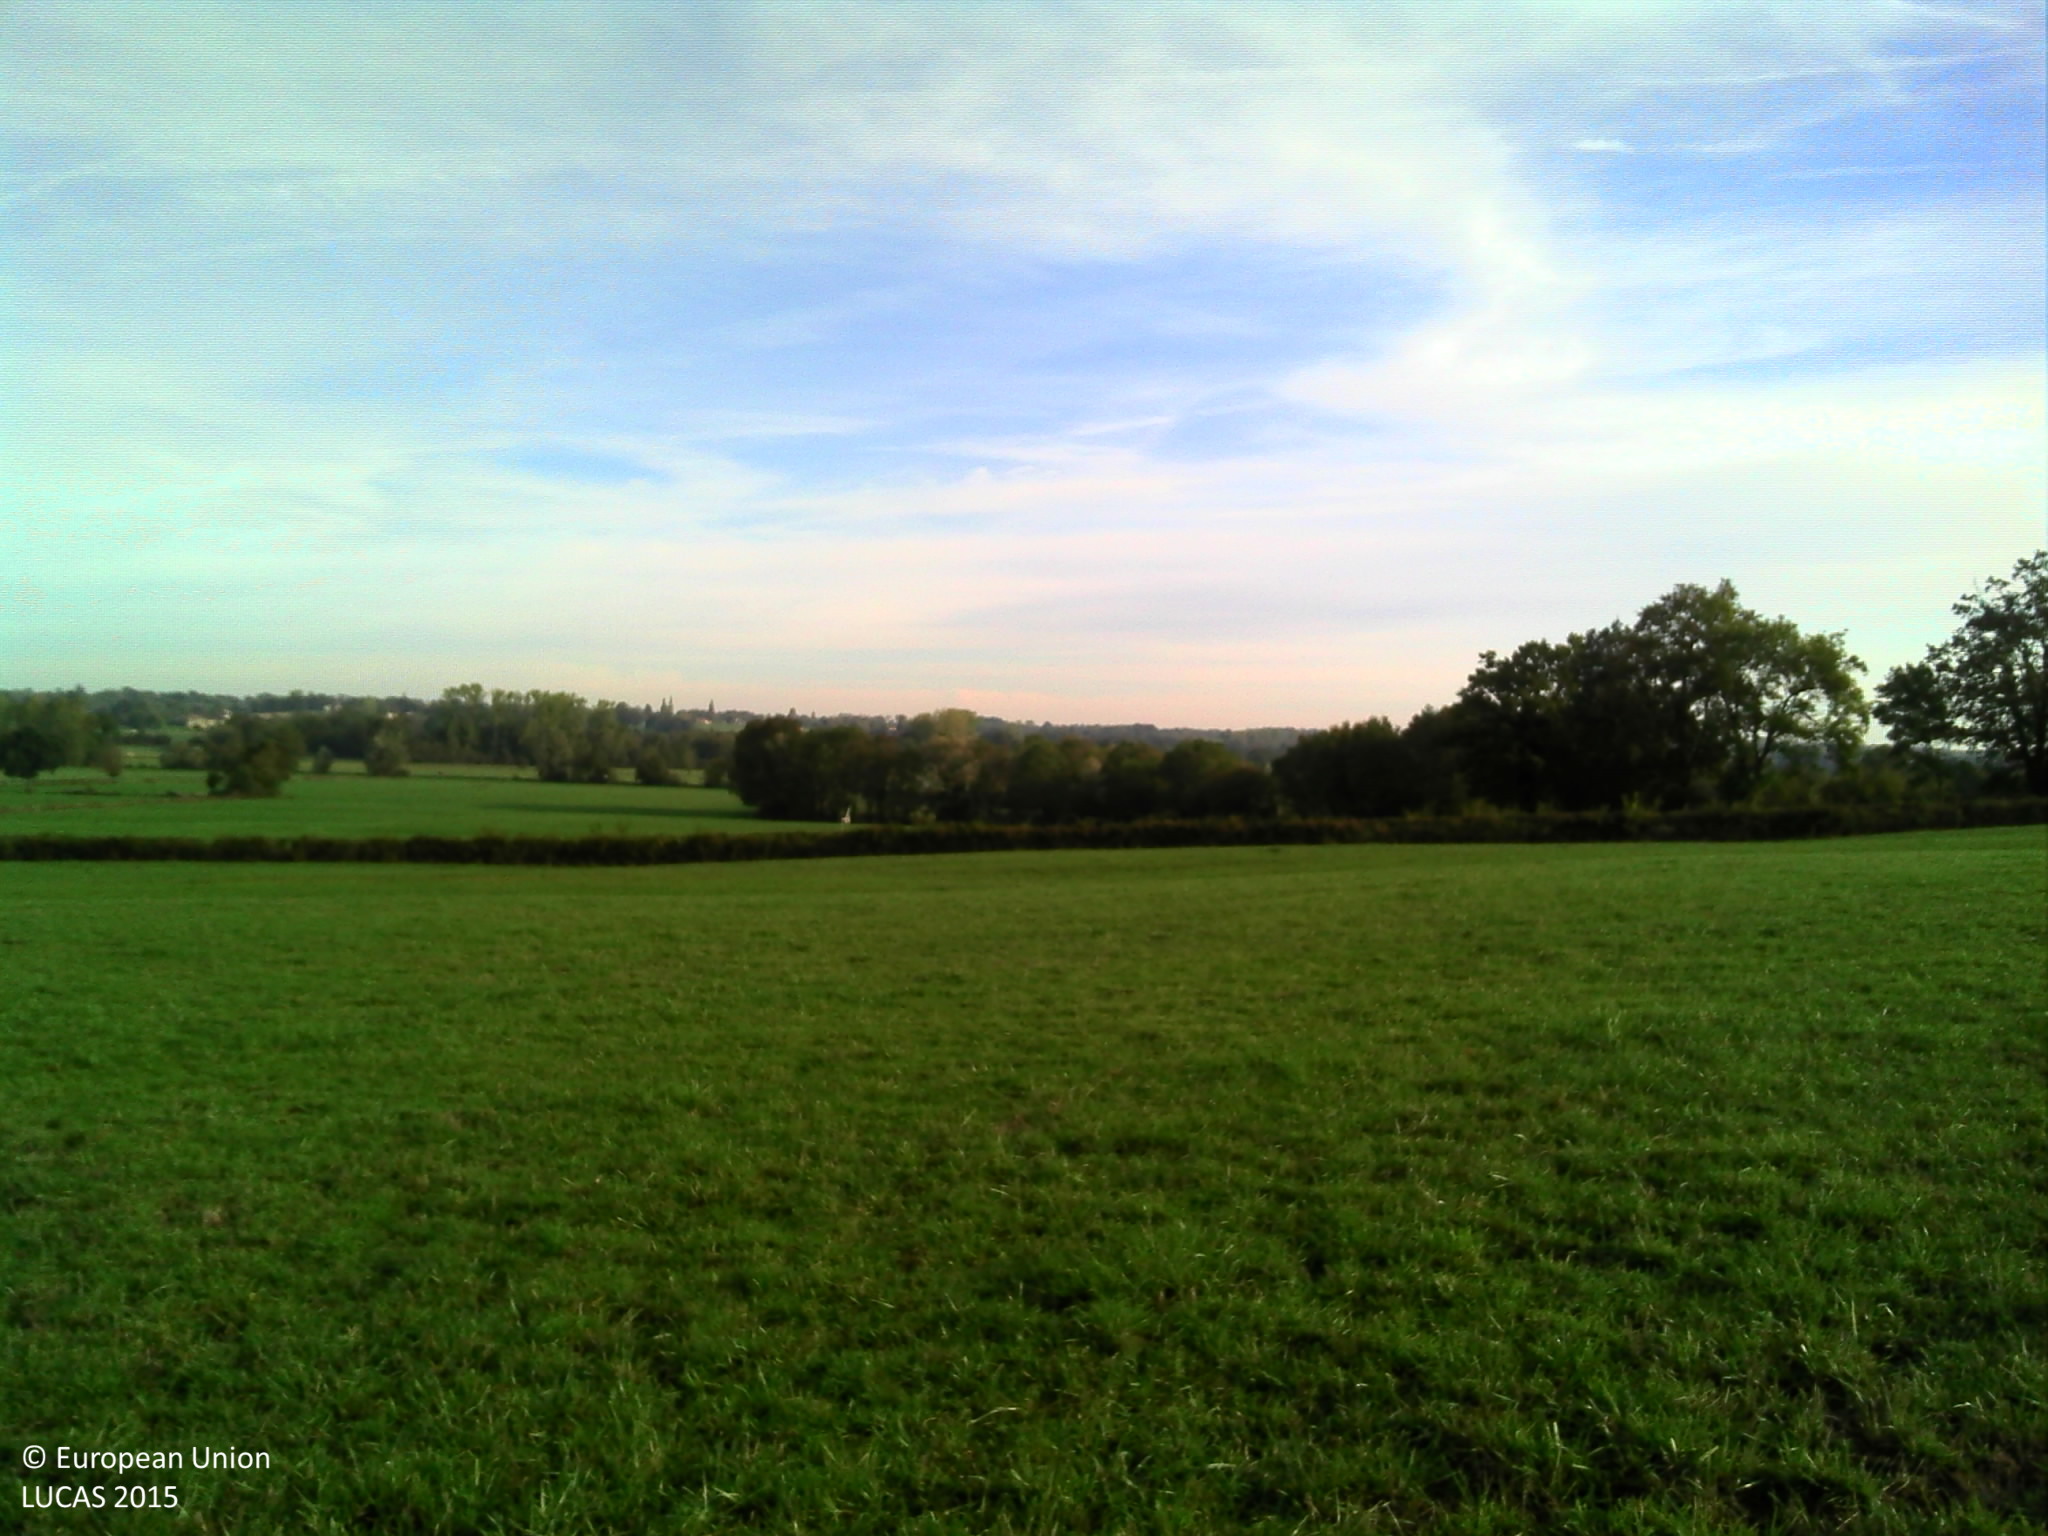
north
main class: Grassland
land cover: Grassland without tree/shrub cover
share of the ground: > 75 %
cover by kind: herbaceous plants 100 %
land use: Agriculture (excluding fallow land and kitchen gardens)
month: October
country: FR
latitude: 46.4145
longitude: 4.9935
